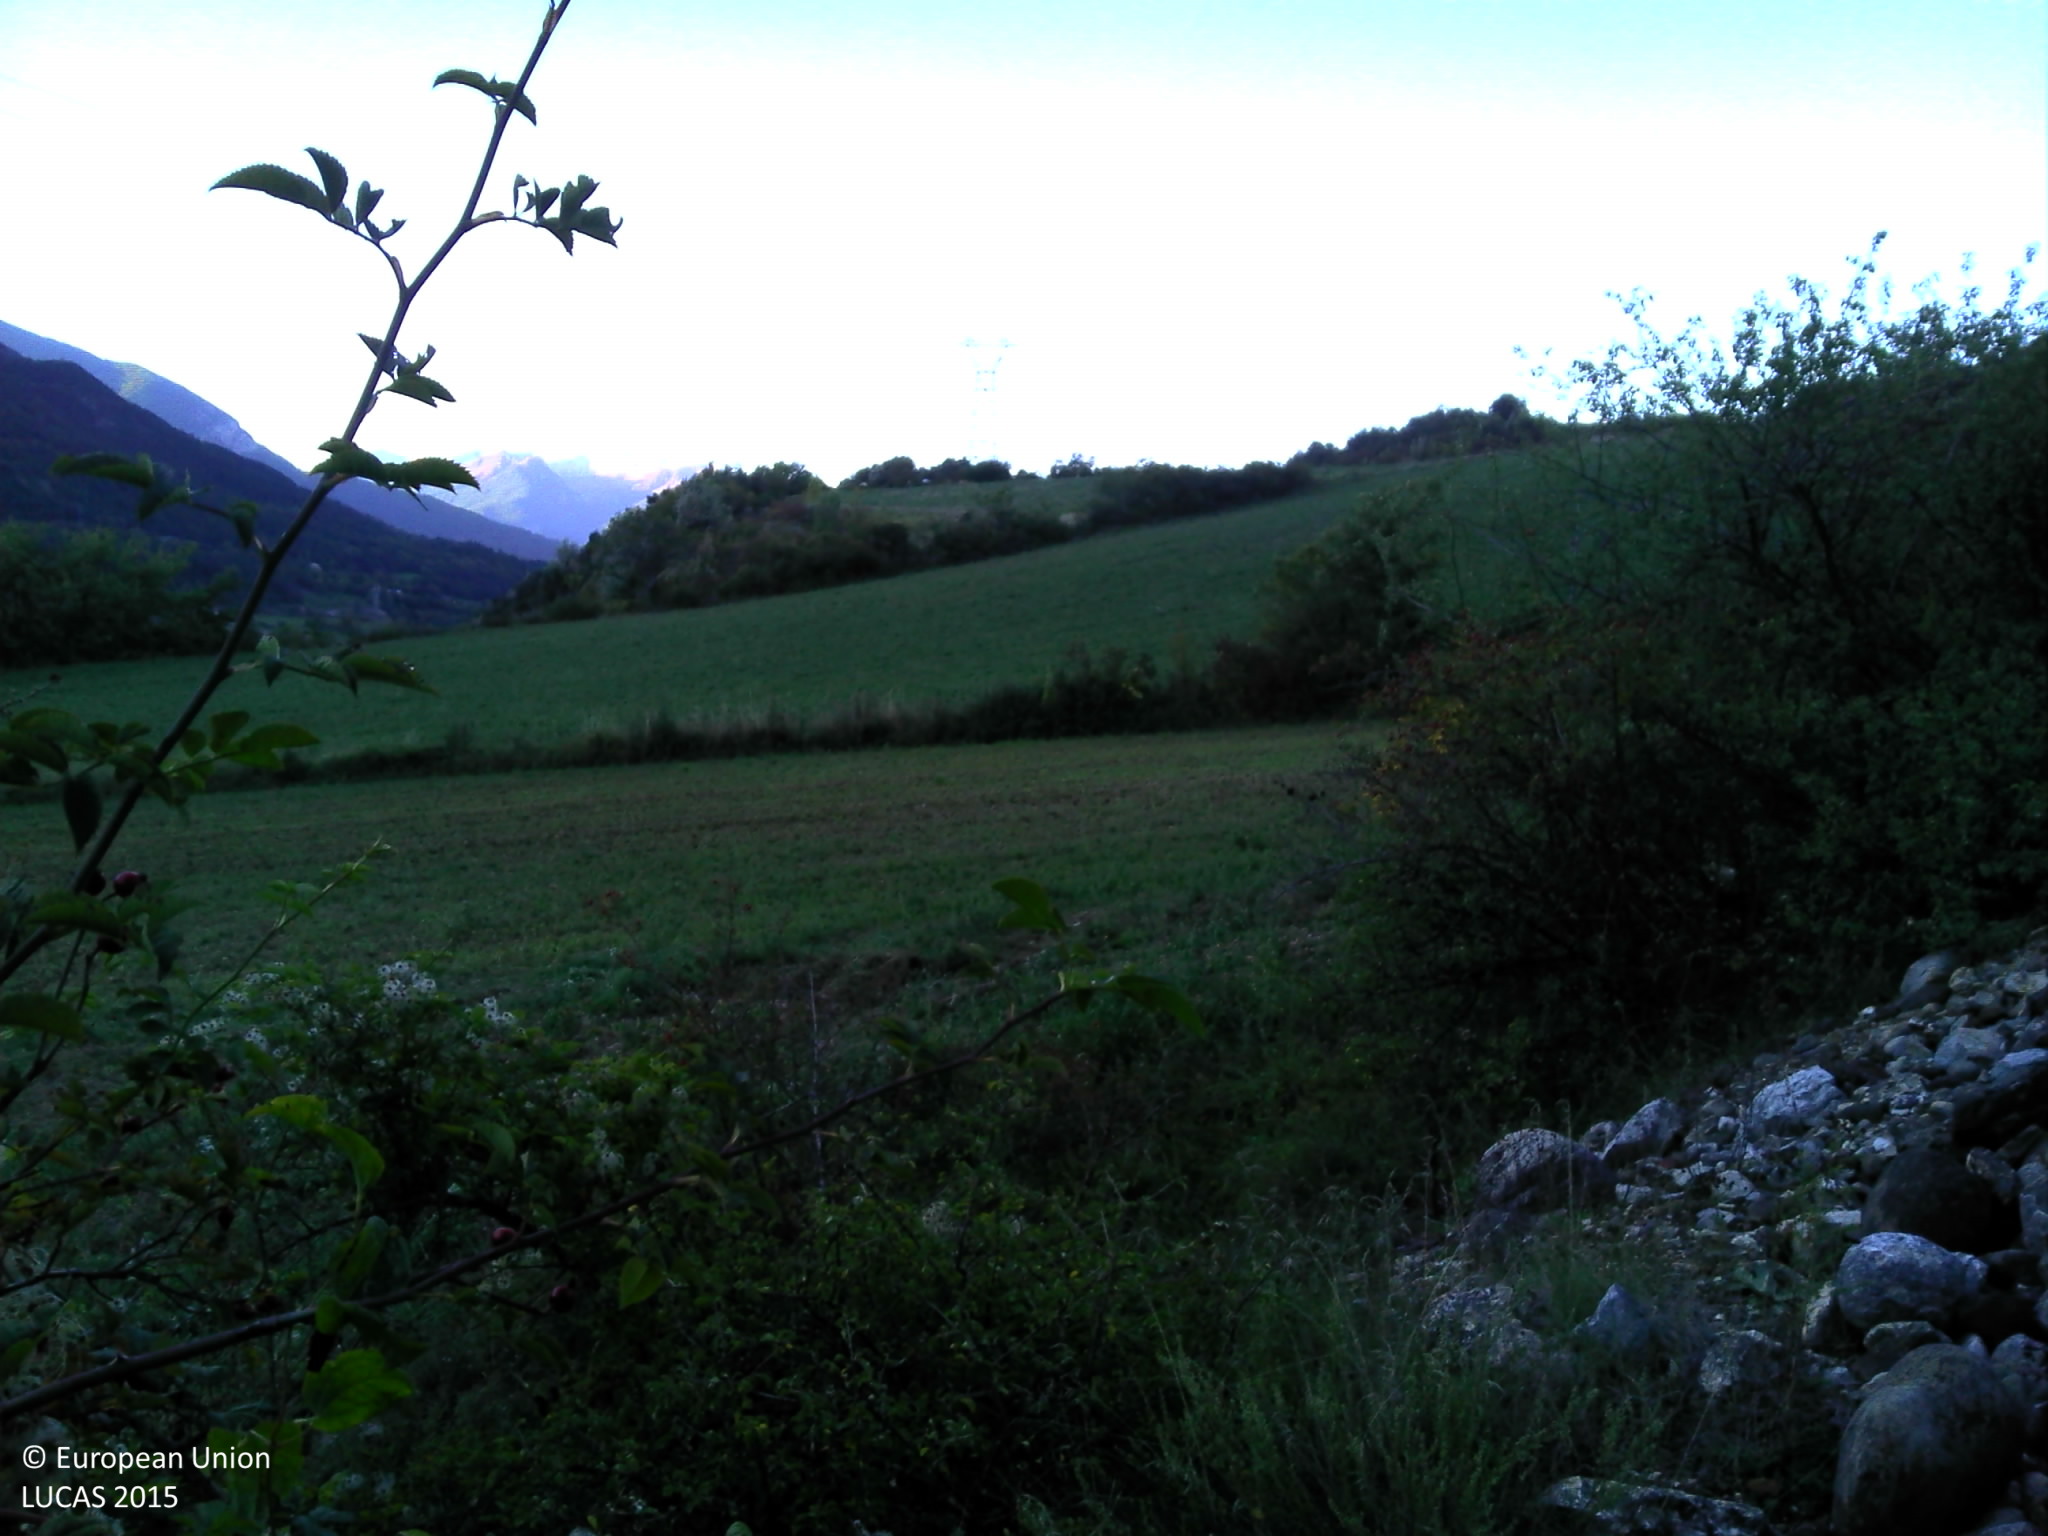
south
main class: Woodland
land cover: Broadleaved woodland
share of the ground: 50 - 75 %
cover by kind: broadleaved forest trees 55 %, shrubs 40 %, herbaceous plants 5 %
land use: Semi-natural and natural areas not in use
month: September
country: FR
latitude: 44.6178
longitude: 6.5405
